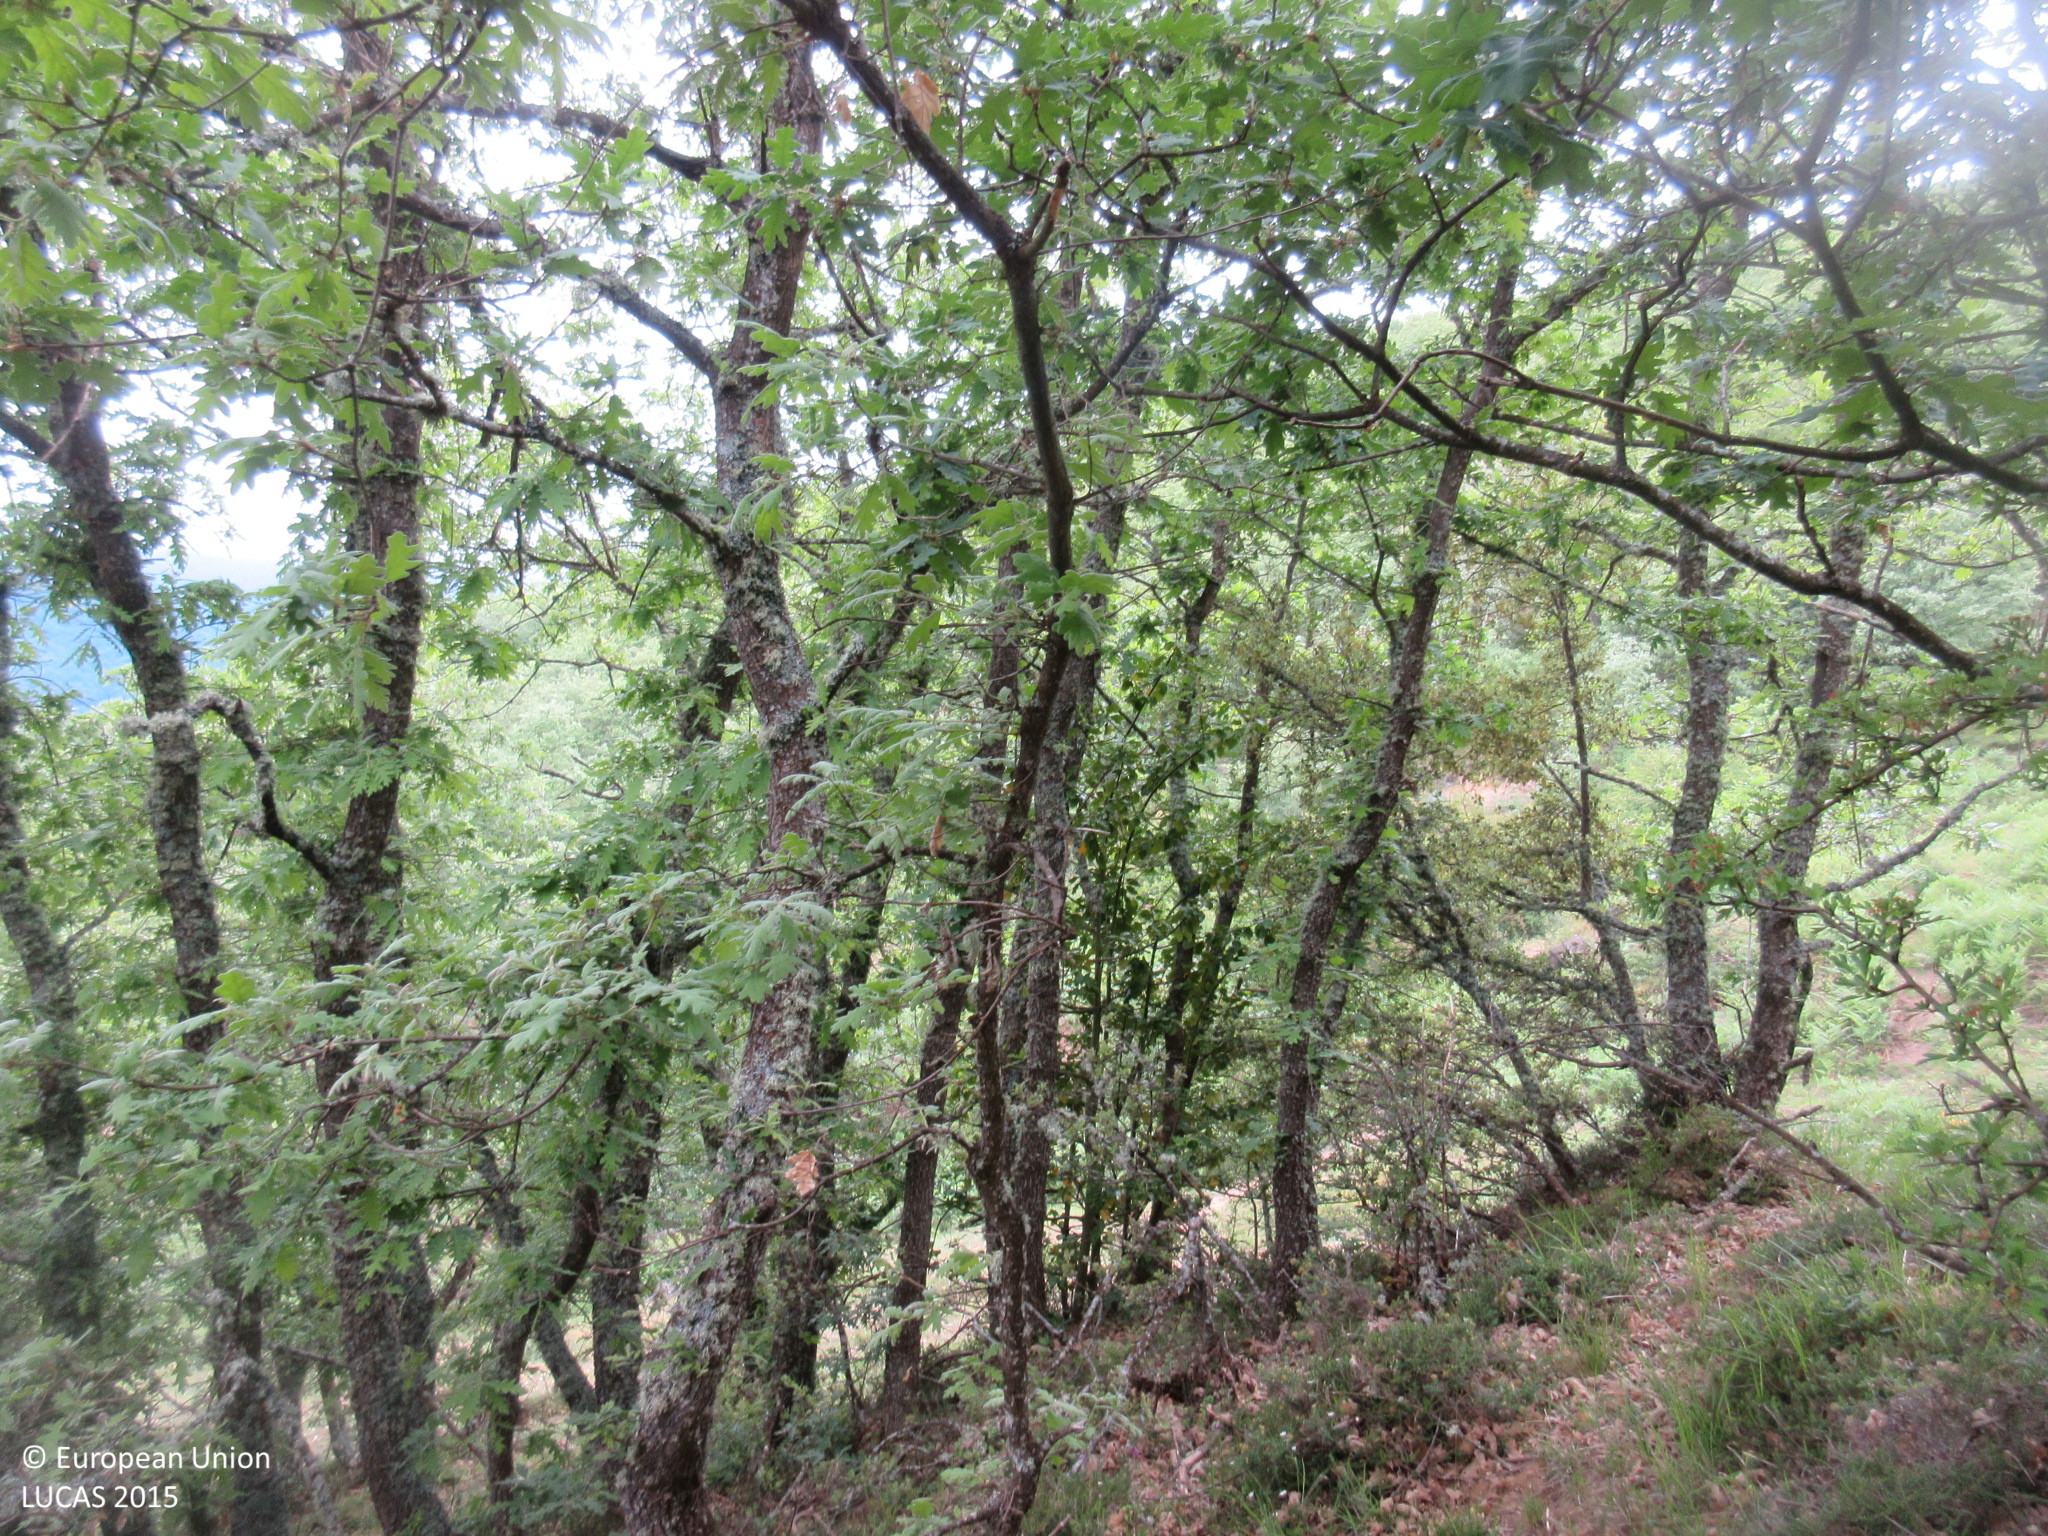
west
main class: Woodland
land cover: Broadleaved woodland
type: acidophilous oak and oak-birch forest
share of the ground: > 75 %
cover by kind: broadleaved forest trees 90 %, shrubs 10 %
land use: Forestry
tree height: > 5 m
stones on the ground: 10 - 25 %
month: June
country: ES
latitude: 43.0997
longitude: -4.5442
